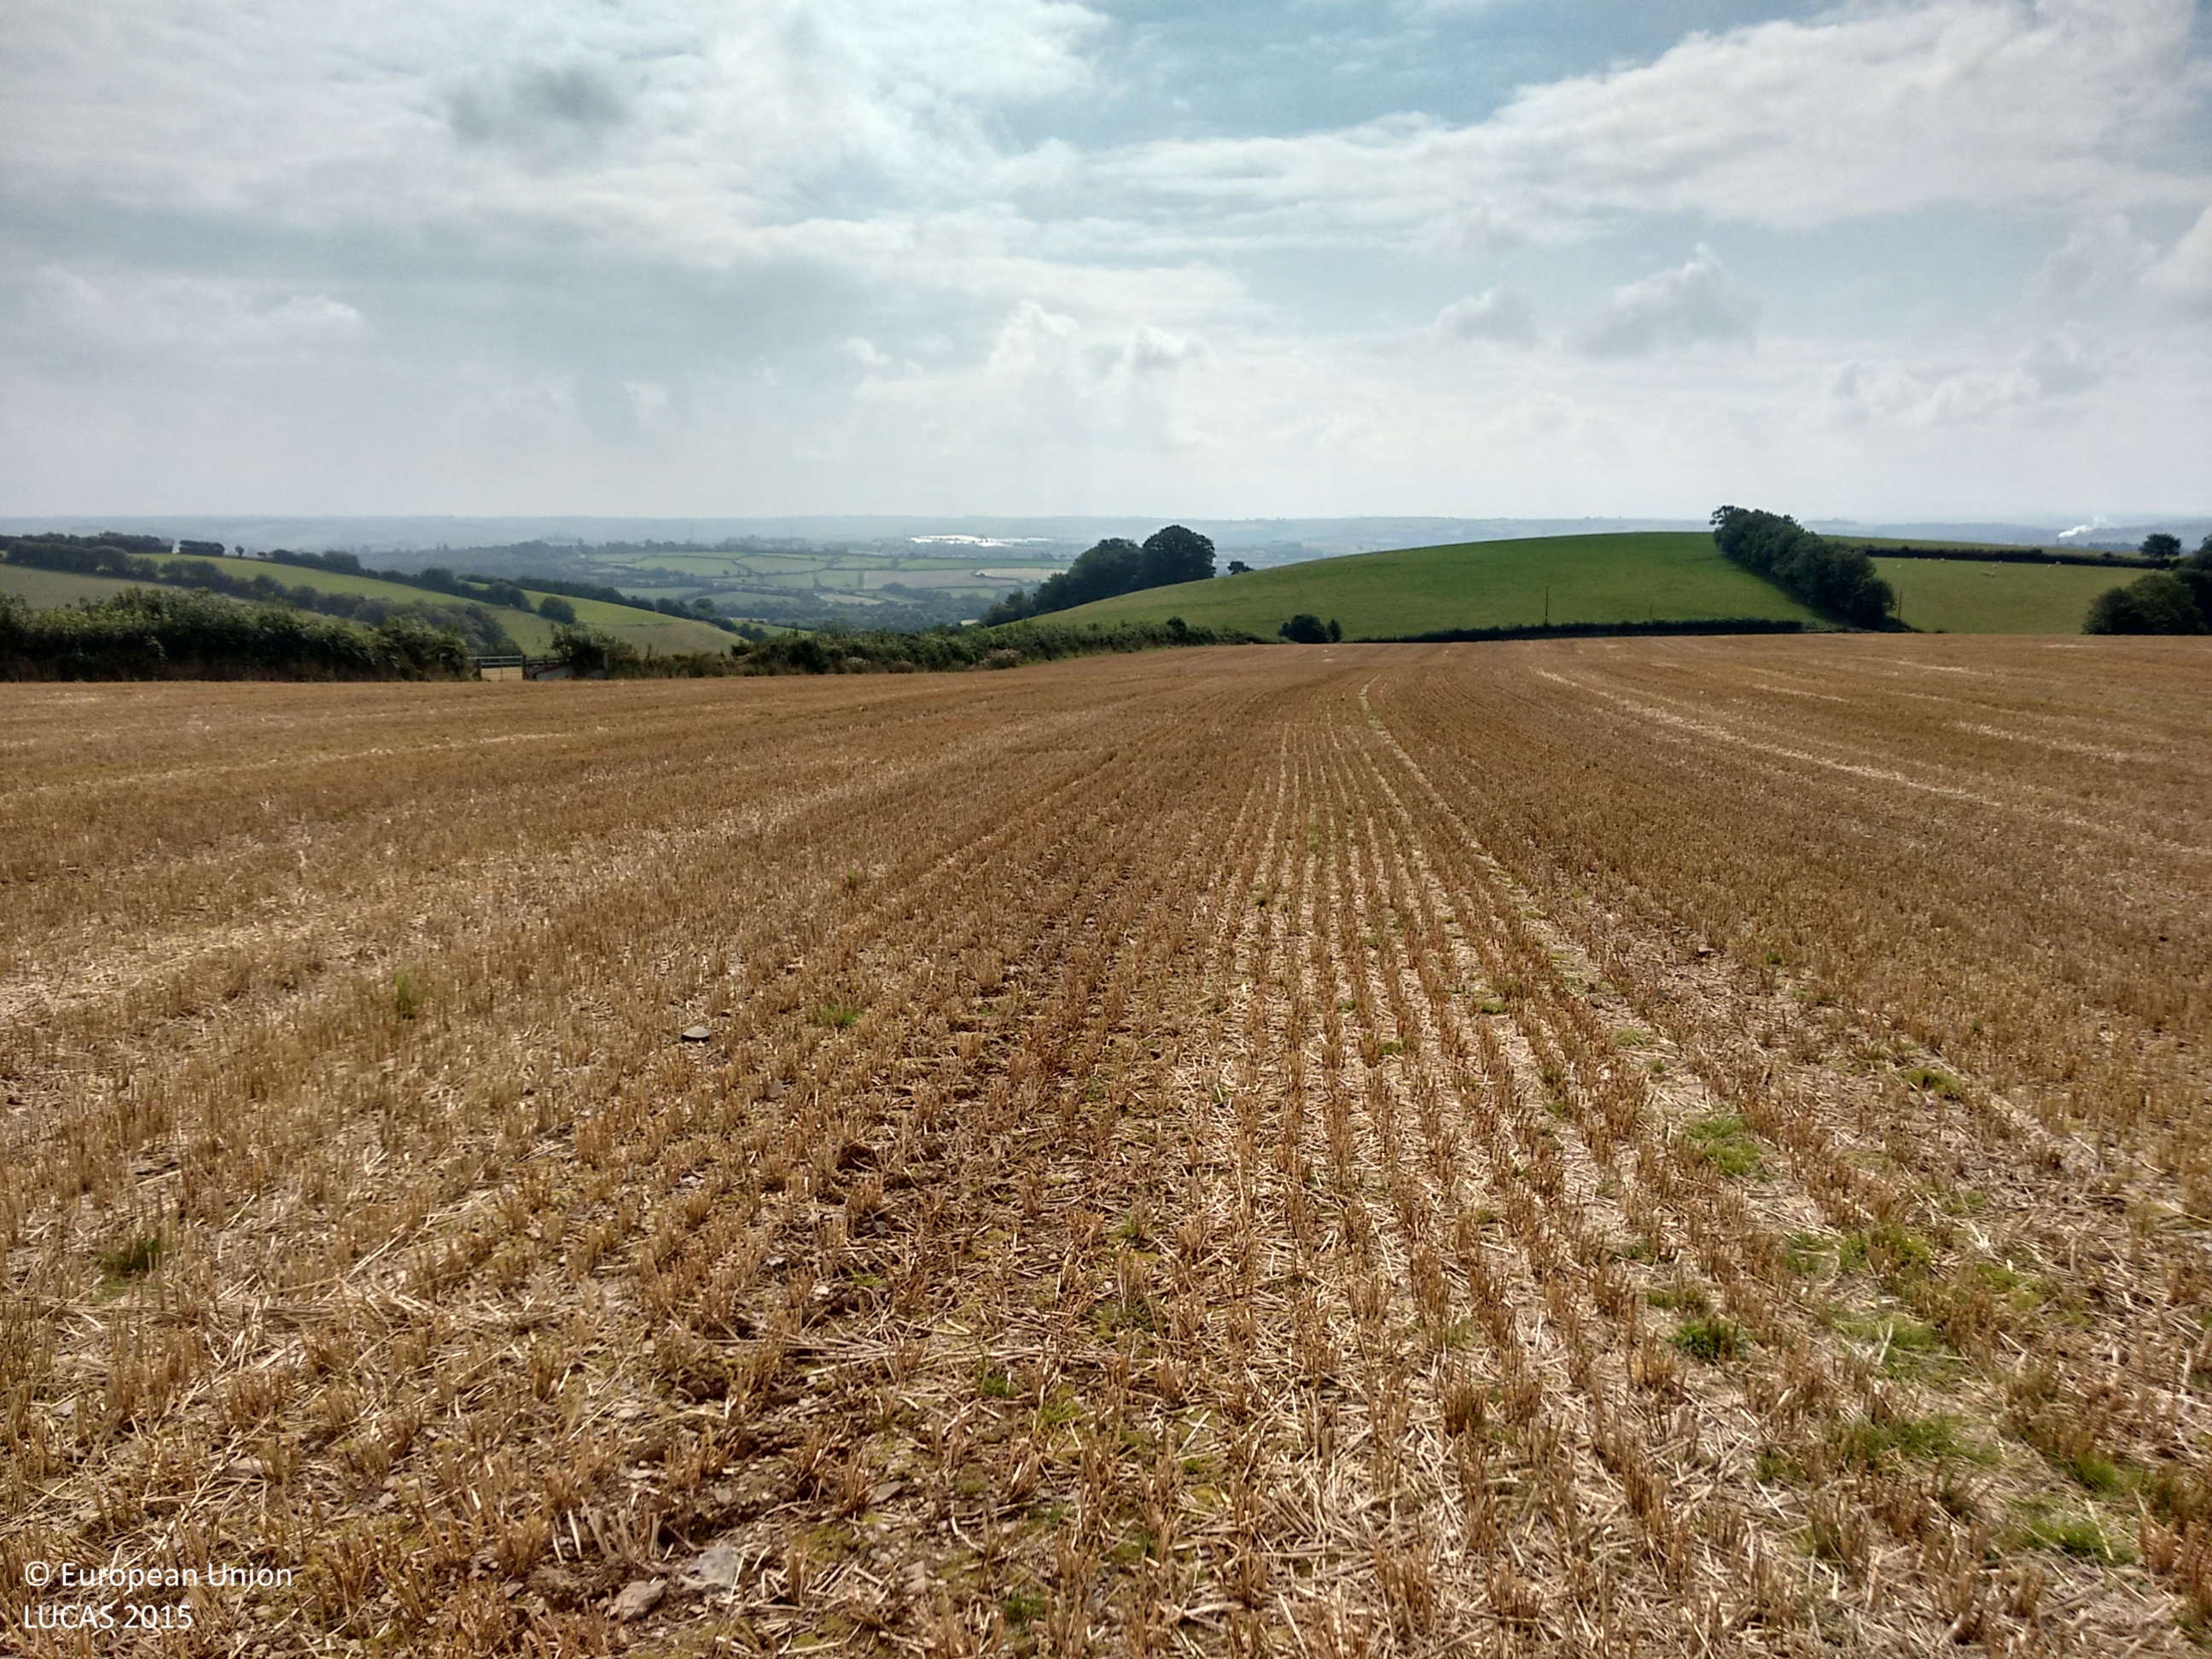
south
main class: Cropland
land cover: Barley
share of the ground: > 75 %
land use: Agriculture (excluding fallow land and kitchen gardens)
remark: Harvested field
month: September
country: GB
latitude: 51.0485
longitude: -3.8567
